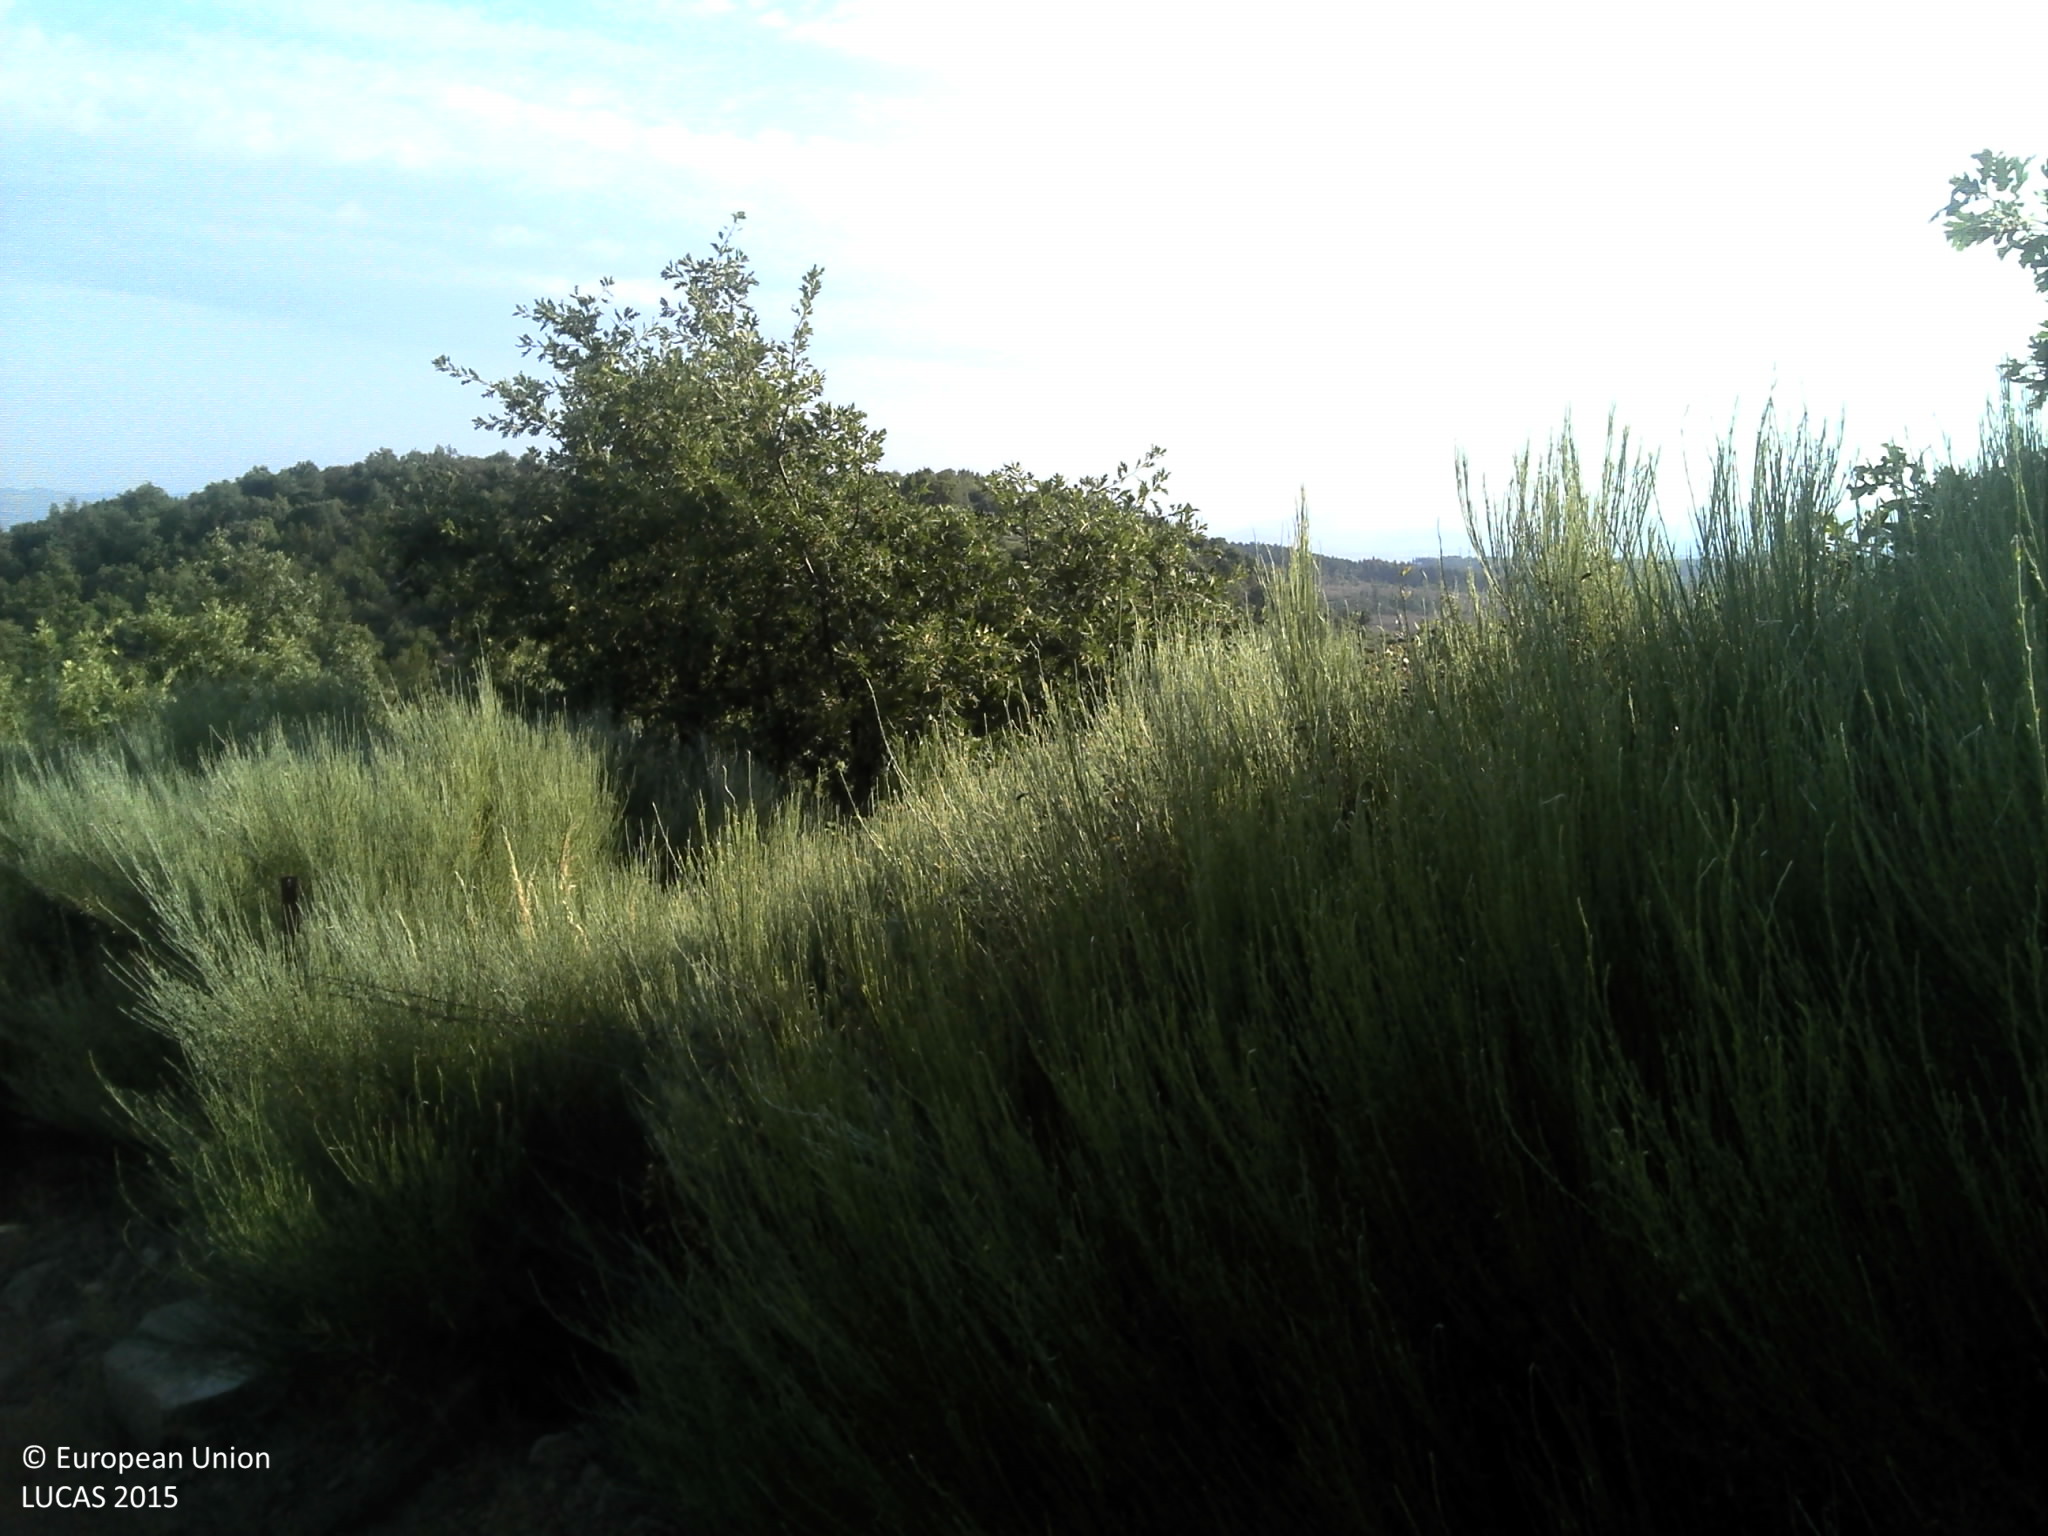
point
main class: Shrubland
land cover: Shrubland with sparse tree cover
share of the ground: > 75 %
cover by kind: shrubs 75 %, unconsolidated bare surface 10 %, broadleaved forest trees 5 %
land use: Forestry
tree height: < 5 m
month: June
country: PT
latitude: 40.2185
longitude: -7.3648
